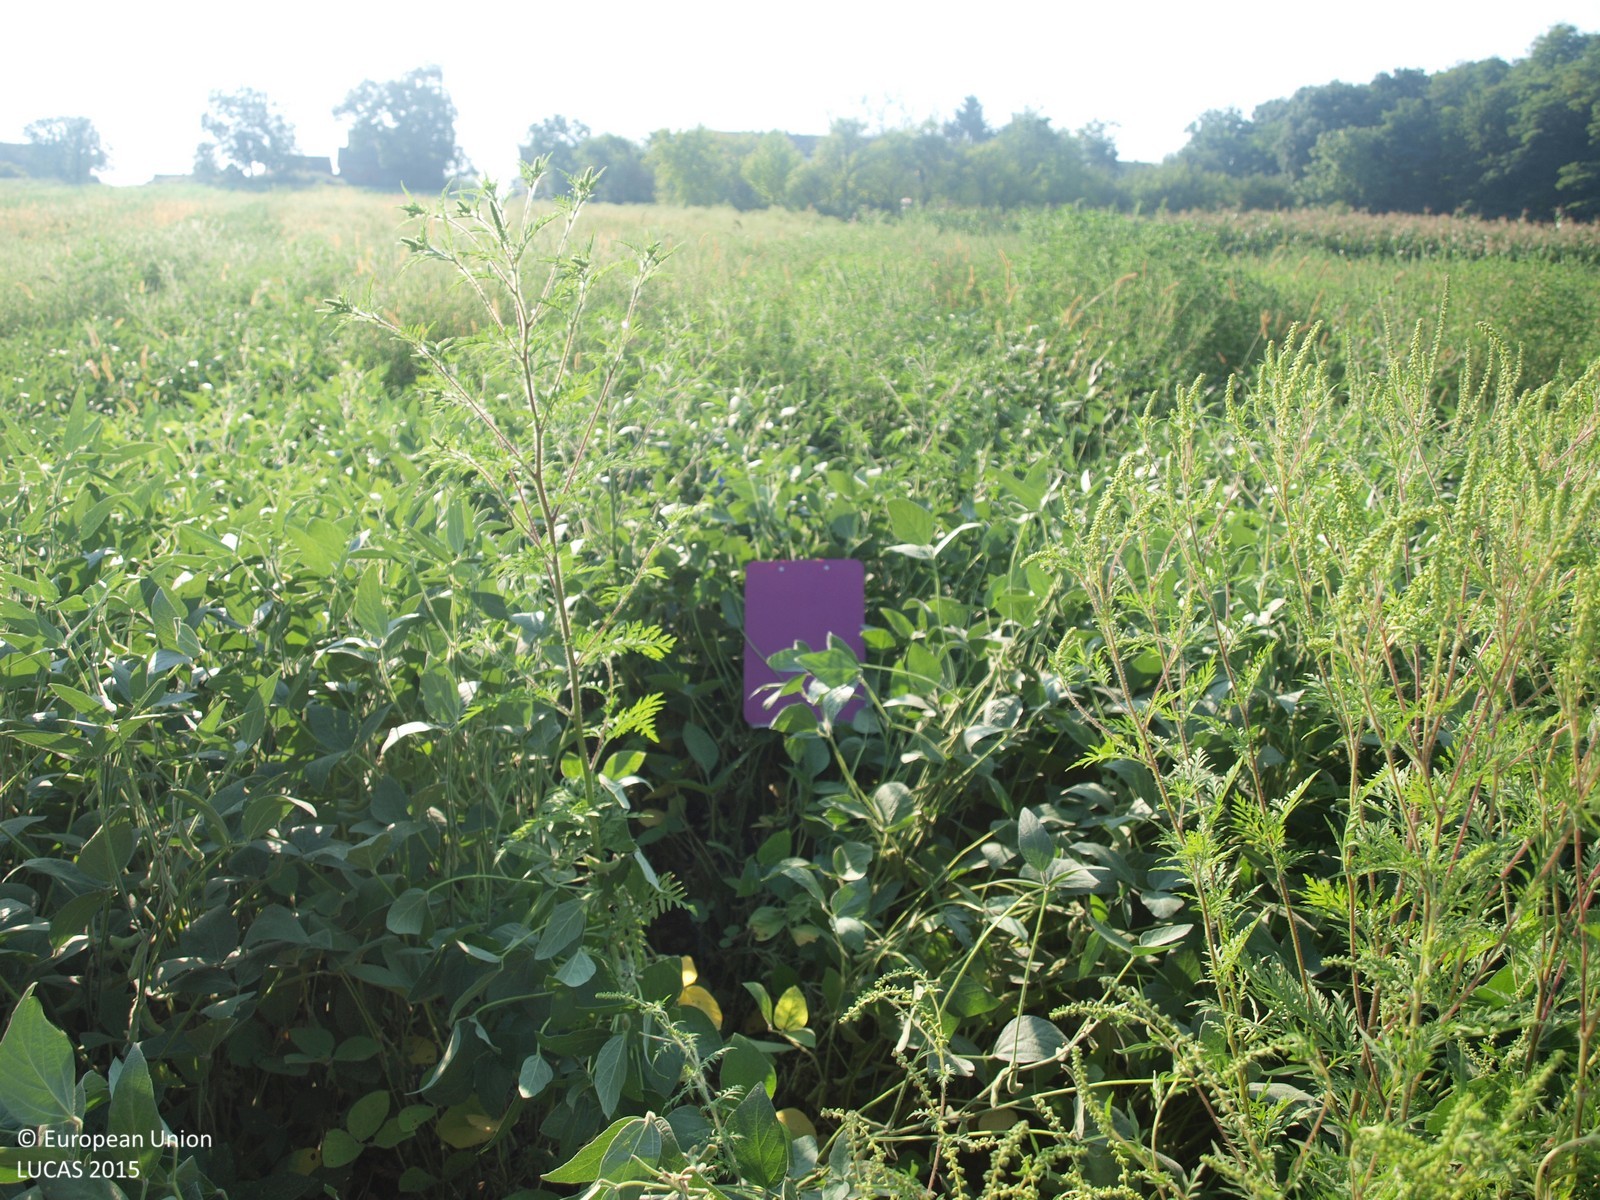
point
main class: Cropland
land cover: Soya
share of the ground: > 75 %
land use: Agriculture (excluding fallow land and kitchen gardens)
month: August
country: HR
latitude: 45.9553
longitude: 16.4893
